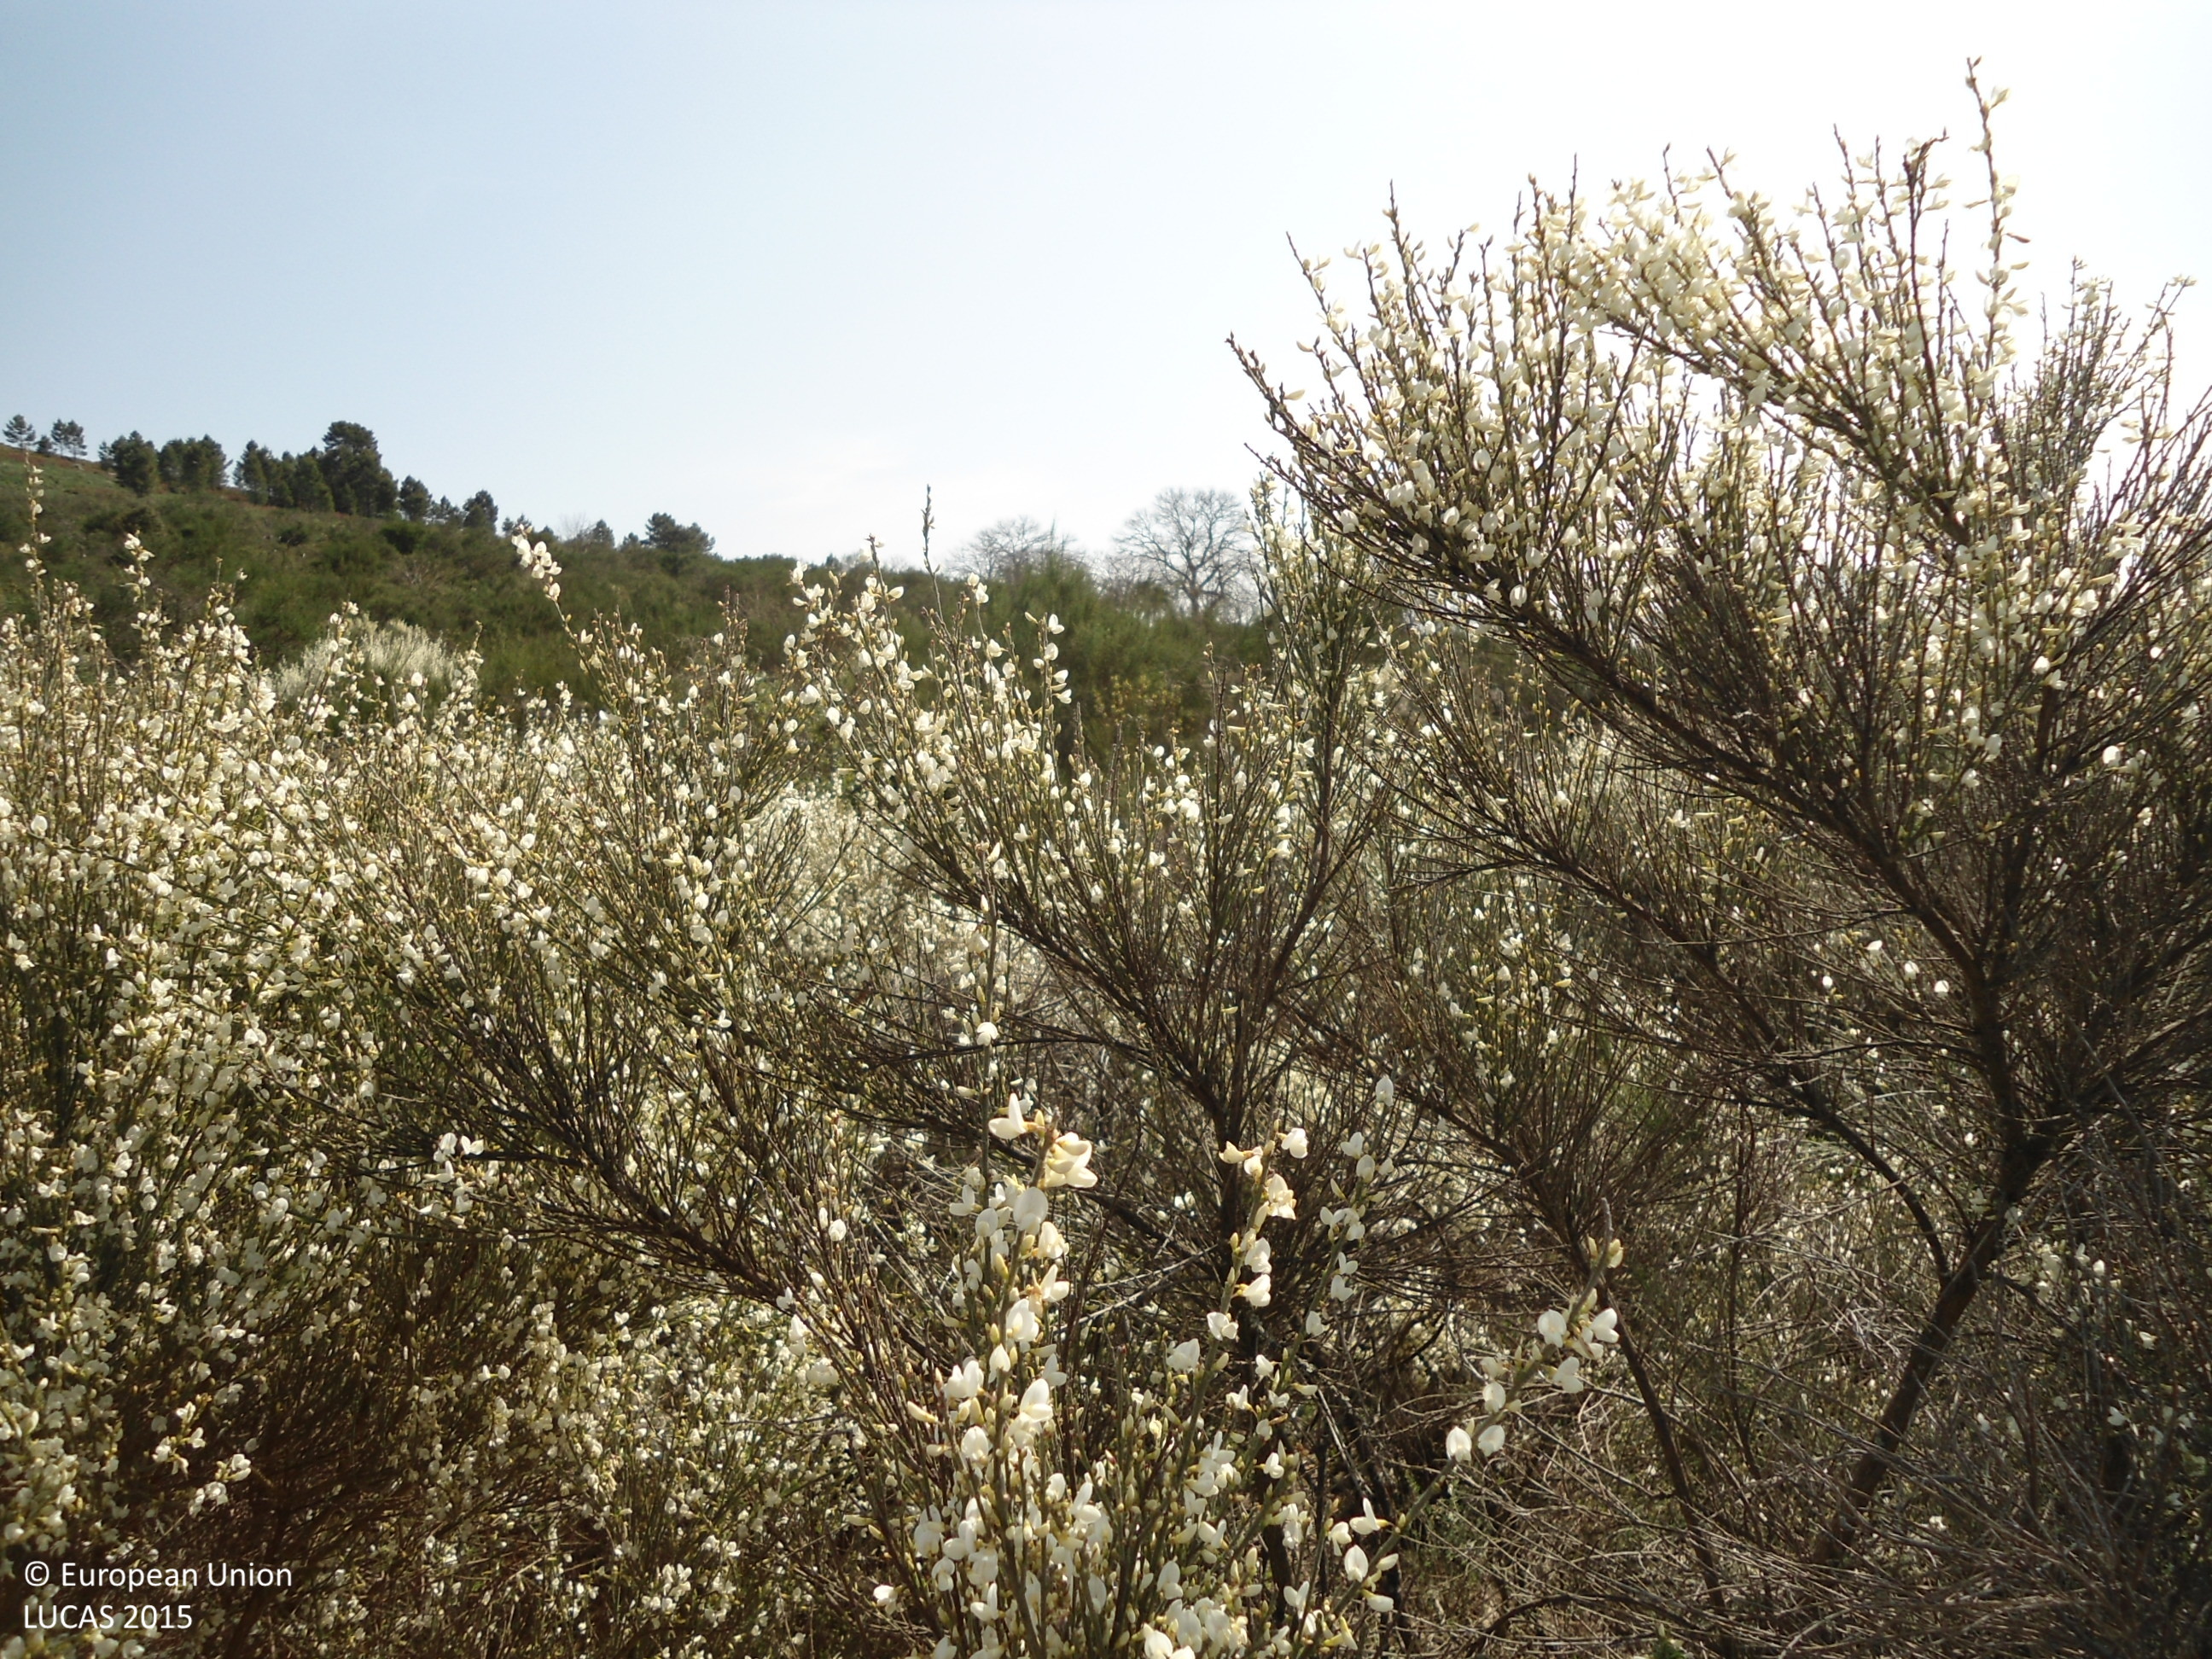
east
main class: Shrubland
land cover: Shrubland without tree cover
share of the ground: > 75 %
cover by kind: shrubs 95 %, herbaceous plants 5 %
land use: Semi-natural and natural areas not in use
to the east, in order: Shrubland without tree cover; Other bare soil; Other fruit trees and berries; Shrubland with sparse tree cover; Other fruit trees and berries; Grassland with sparse tree/shrub cover; Tracks; Shrubland with sparse tree cover
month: April
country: ES
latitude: 41.6759
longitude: -6.5017
